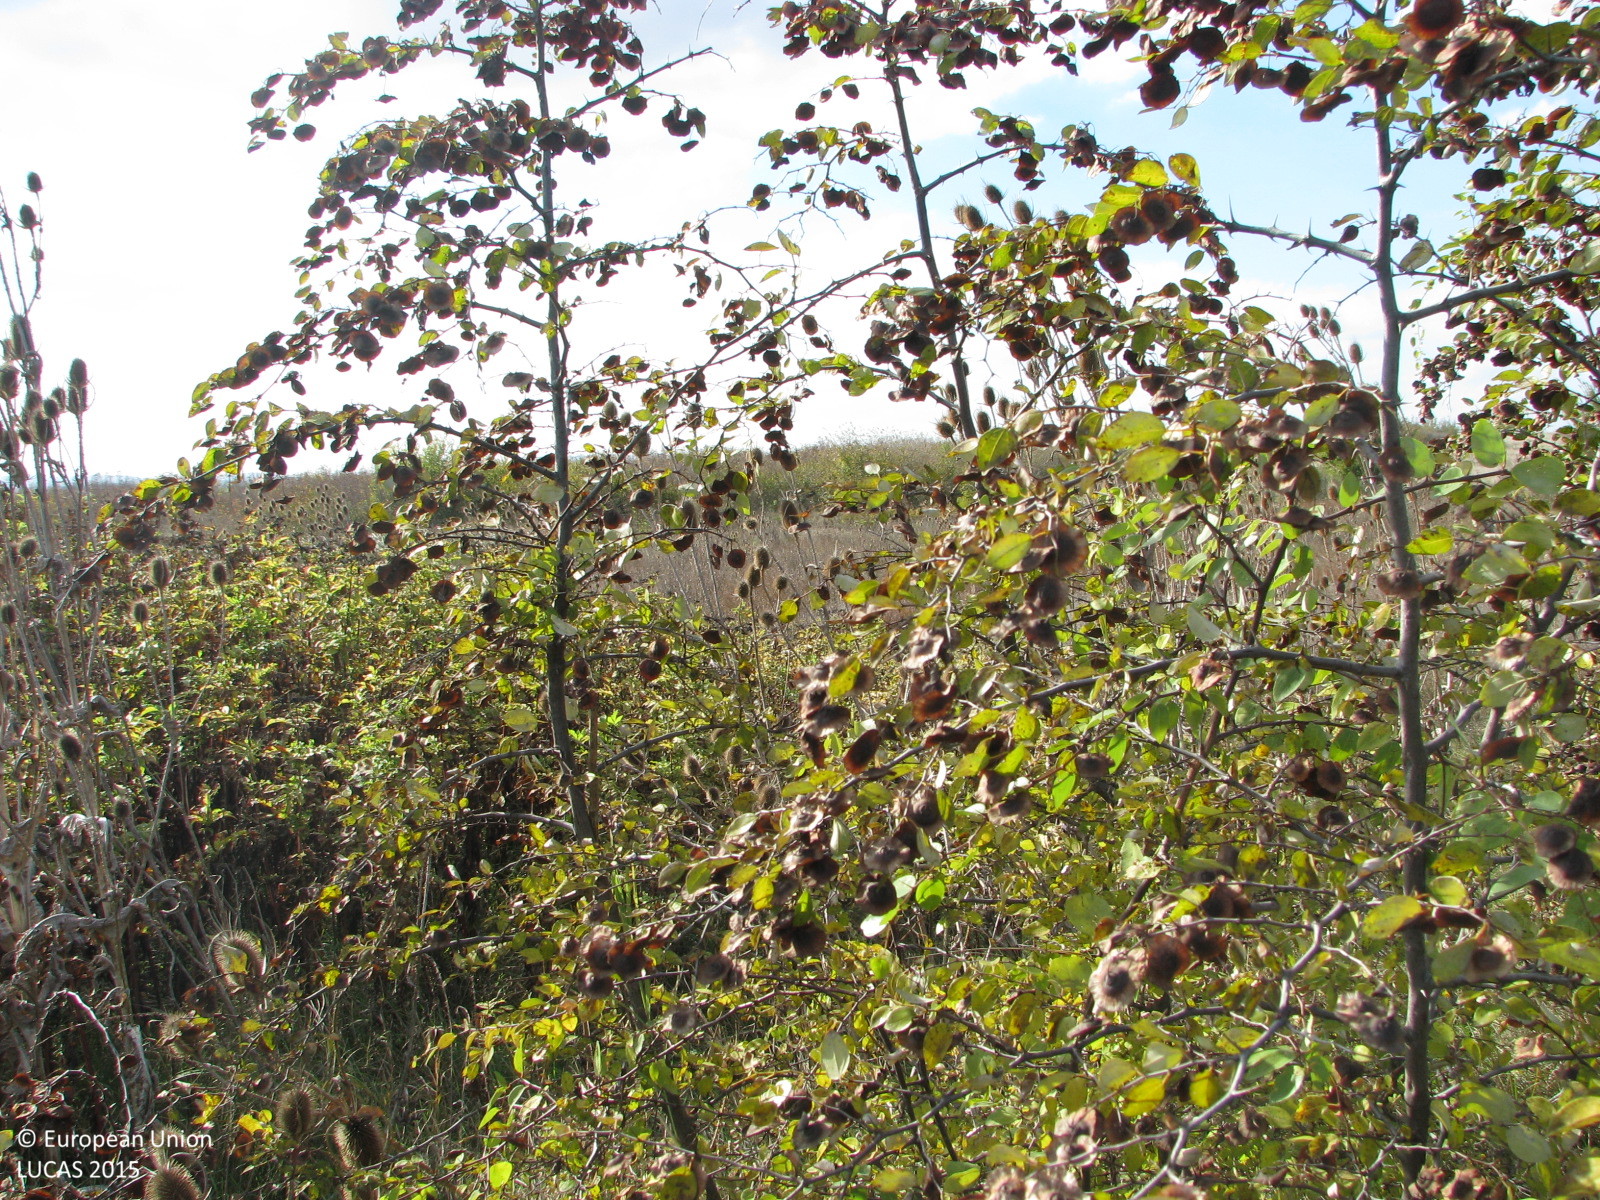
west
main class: Shrubland
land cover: Shrubland without tree cover
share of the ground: 50 - 75 %
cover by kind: shrubs 70 %, herbaceous plants 30 %
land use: Semi-natural and natural areas not in use
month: November
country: BG
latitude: 42.4778
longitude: 26.8757
